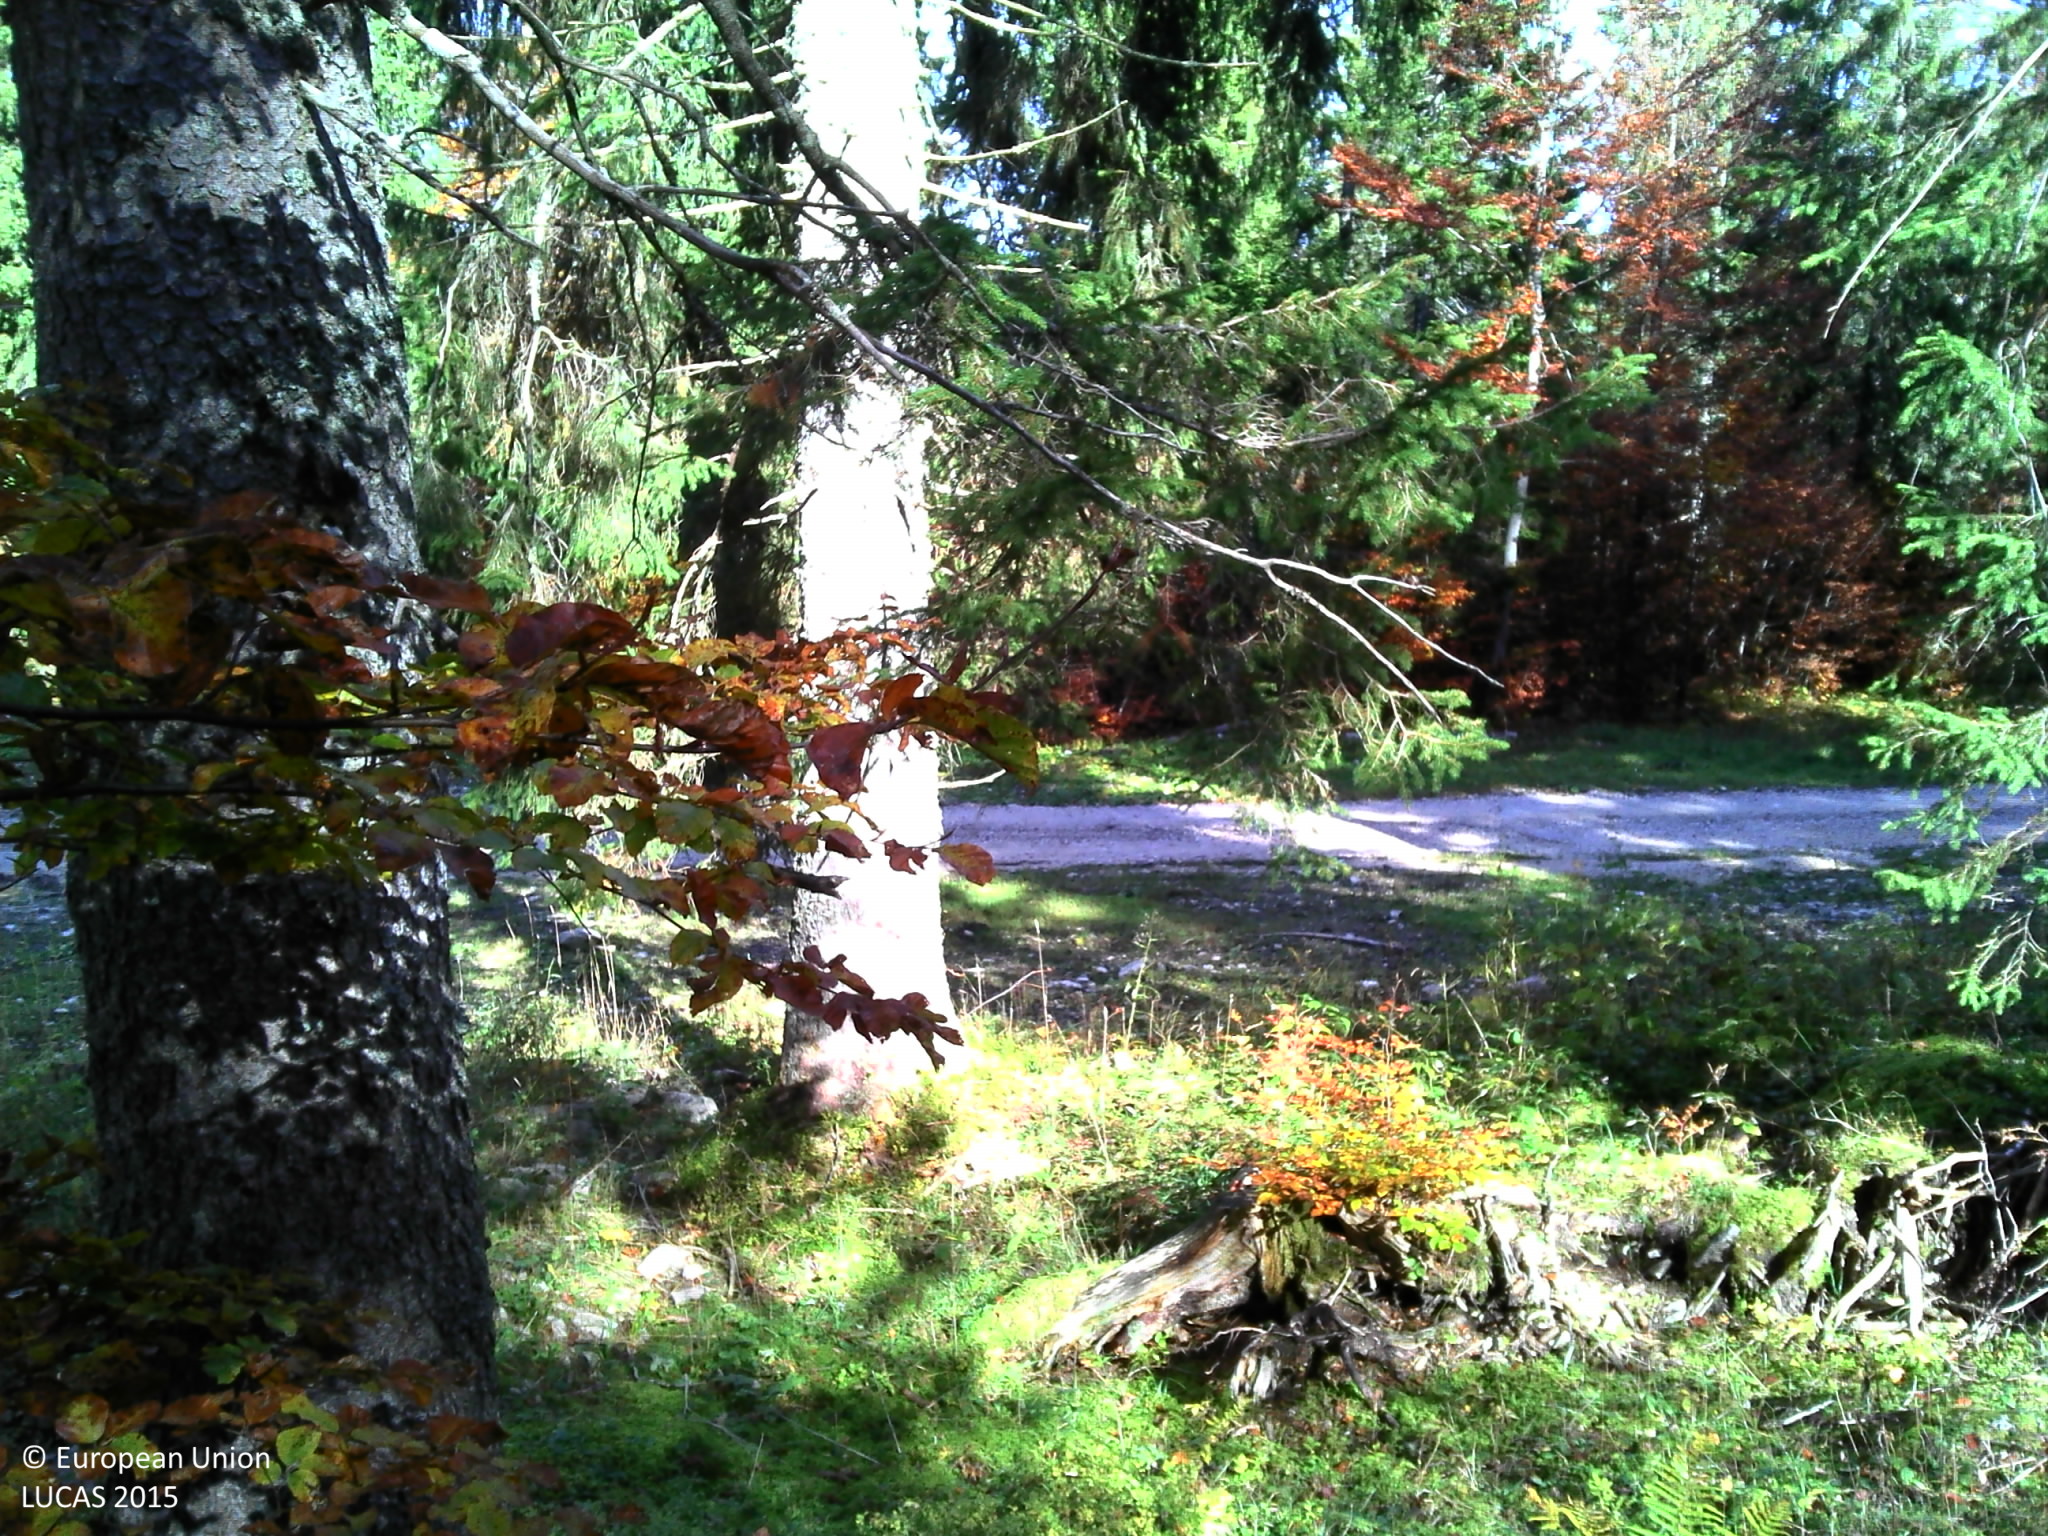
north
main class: Woodland
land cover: Spruce dominated mixed woodland
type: mountainous beech forest
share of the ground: > 75 %
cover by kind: broadleaved forest trees 40 %, coniferous forest trees 30 %, herbaceous plants 10 %, lichens and mosses 10 %, consolidated bare surface 5 %, unconsolidated bare surface 5 %
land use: Forestry
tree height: > 5 m
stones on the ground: 10 - 25 %
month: October
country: FR
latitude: 46.6245
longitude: 6.1501
